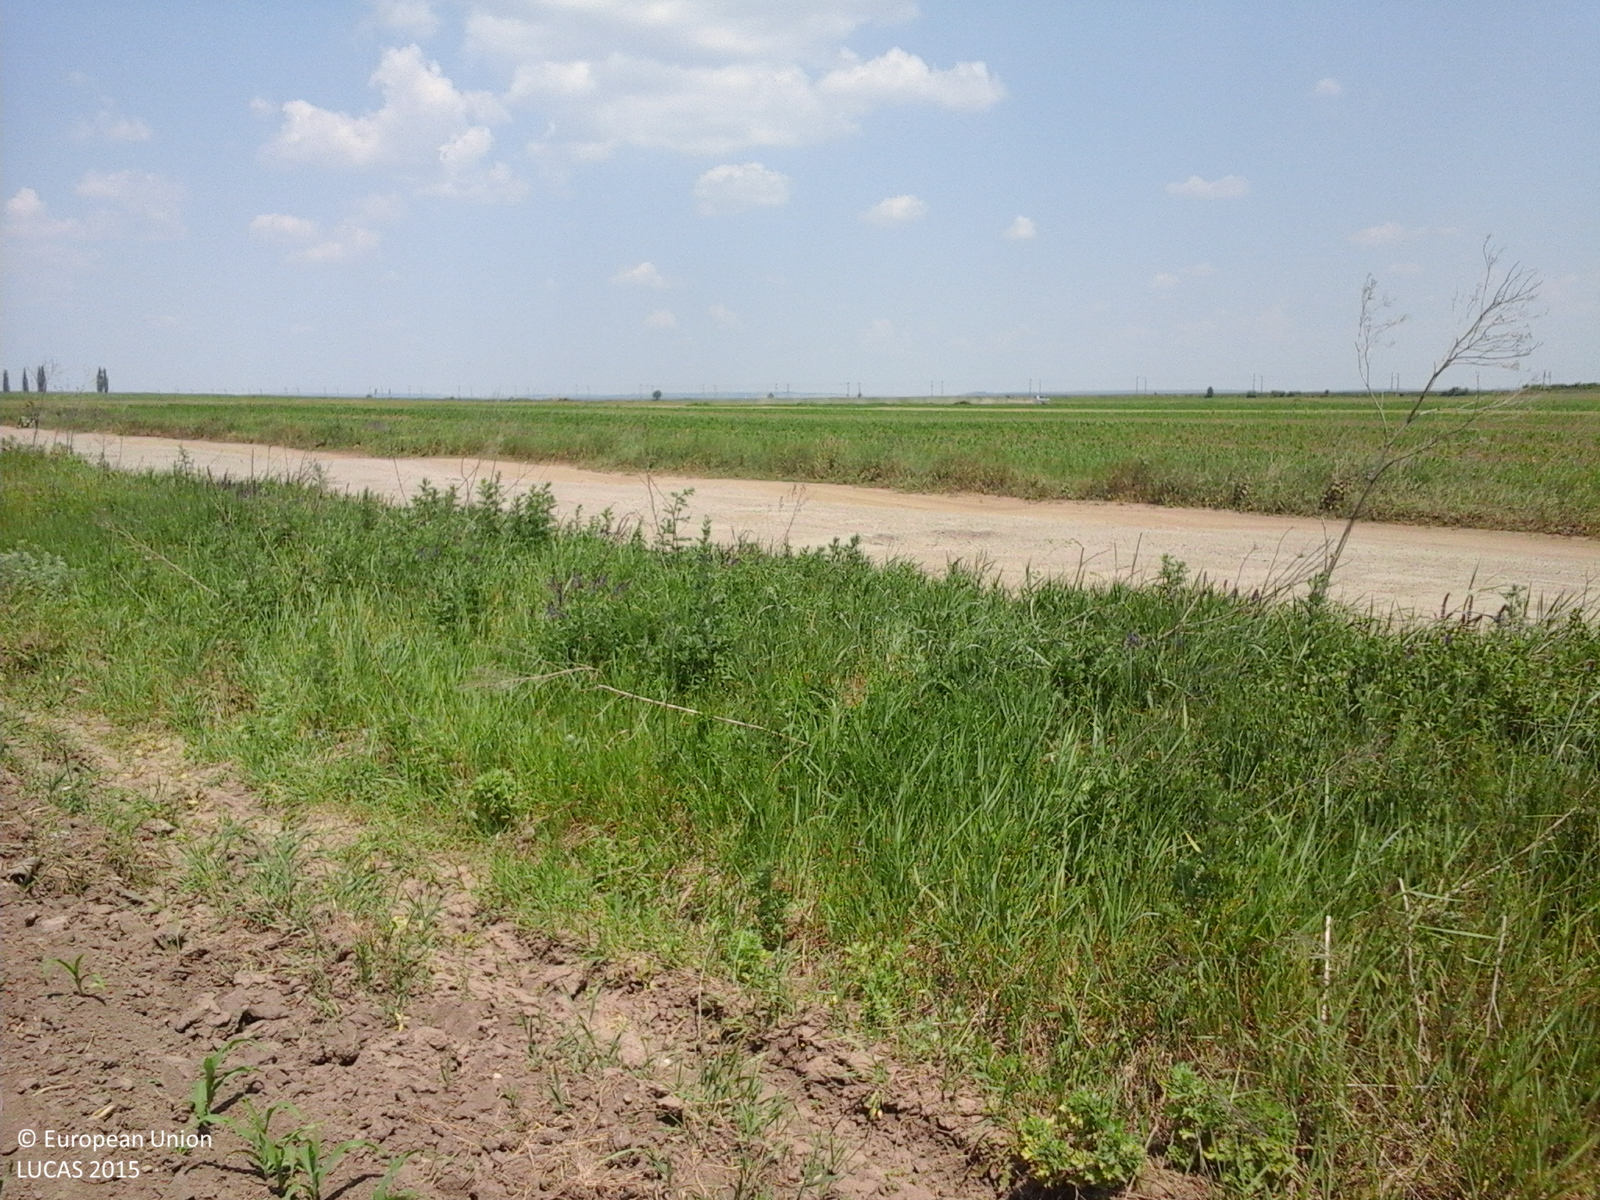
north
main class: Cropland
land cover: Maize
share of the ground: 25 - 50 %
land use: Agriculture (excluding fallow land and kitchen gardens)
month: June
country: RO
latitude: 47.0426
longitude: 26.8503
